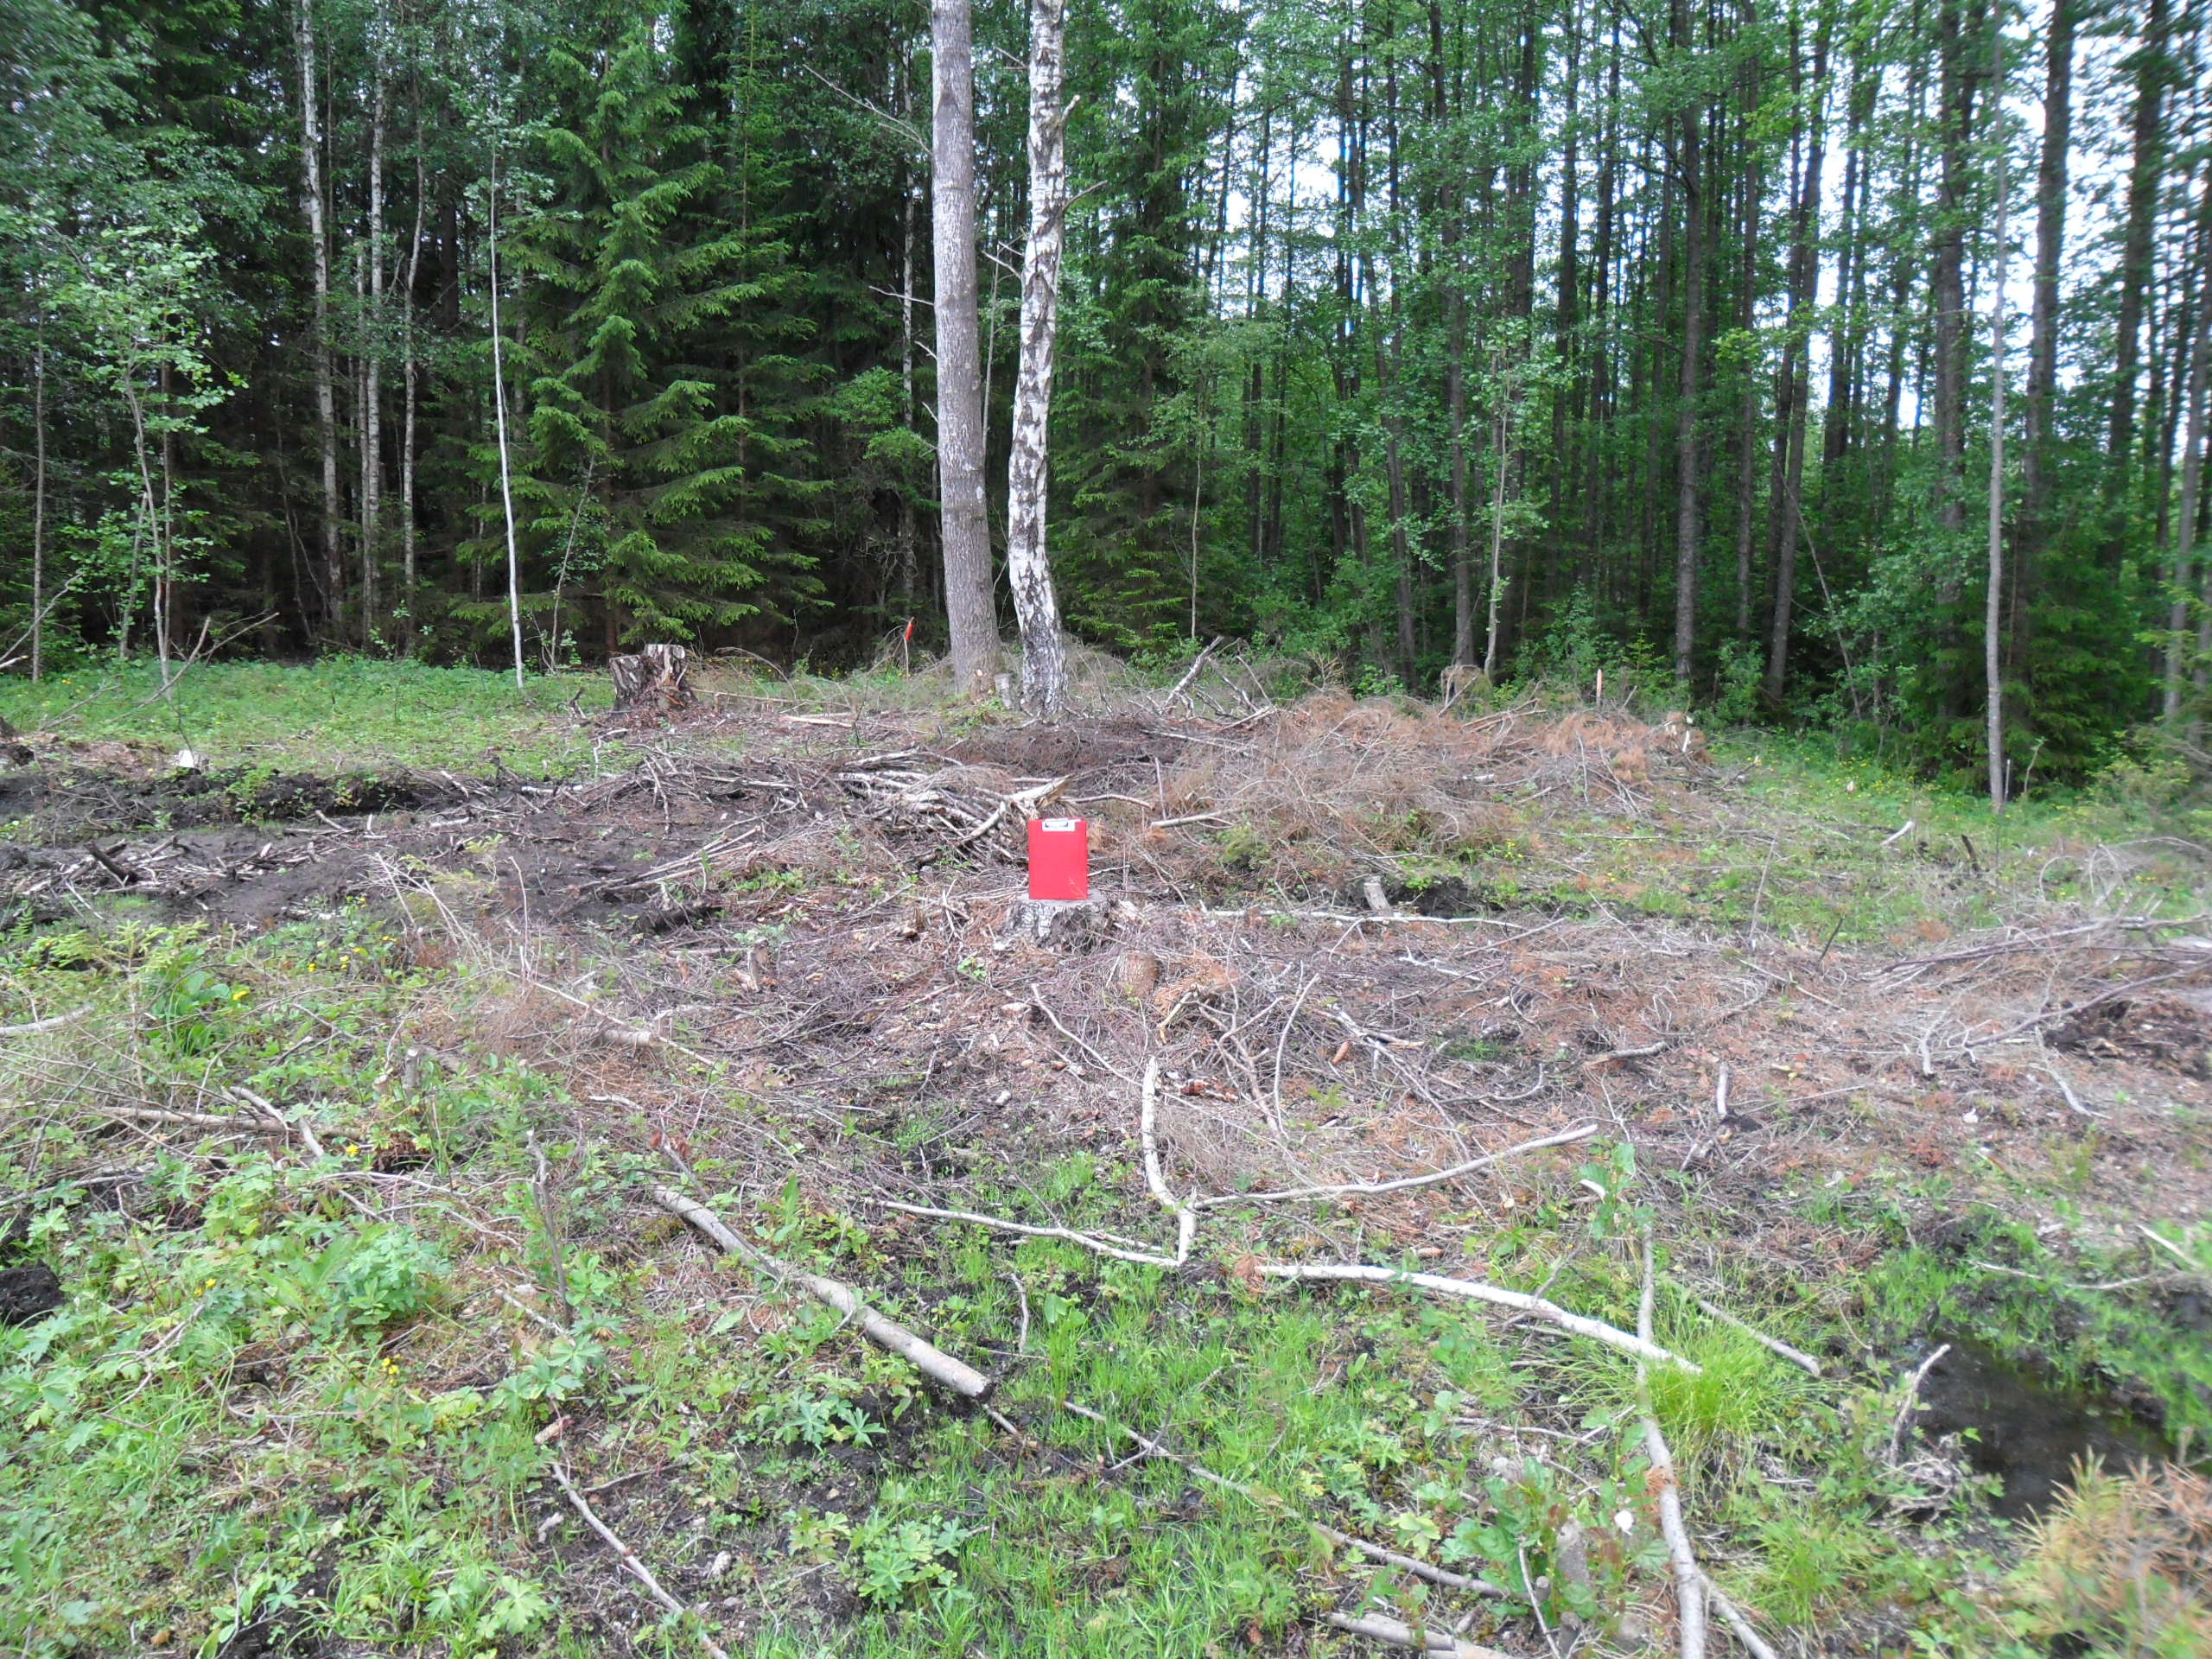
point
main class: Grassland
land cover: Grassland with sparse tree/shrub cover
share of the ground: > 75 %
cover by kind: herbaceous plants 85 %, broadleaved forest trees 5 %, shrubs 5 %, lichens and mosses 5 %
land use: Forestry
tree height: > 5 m
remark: Clear cut
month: June
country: LV
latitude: 57.4288
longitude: 21.9529
